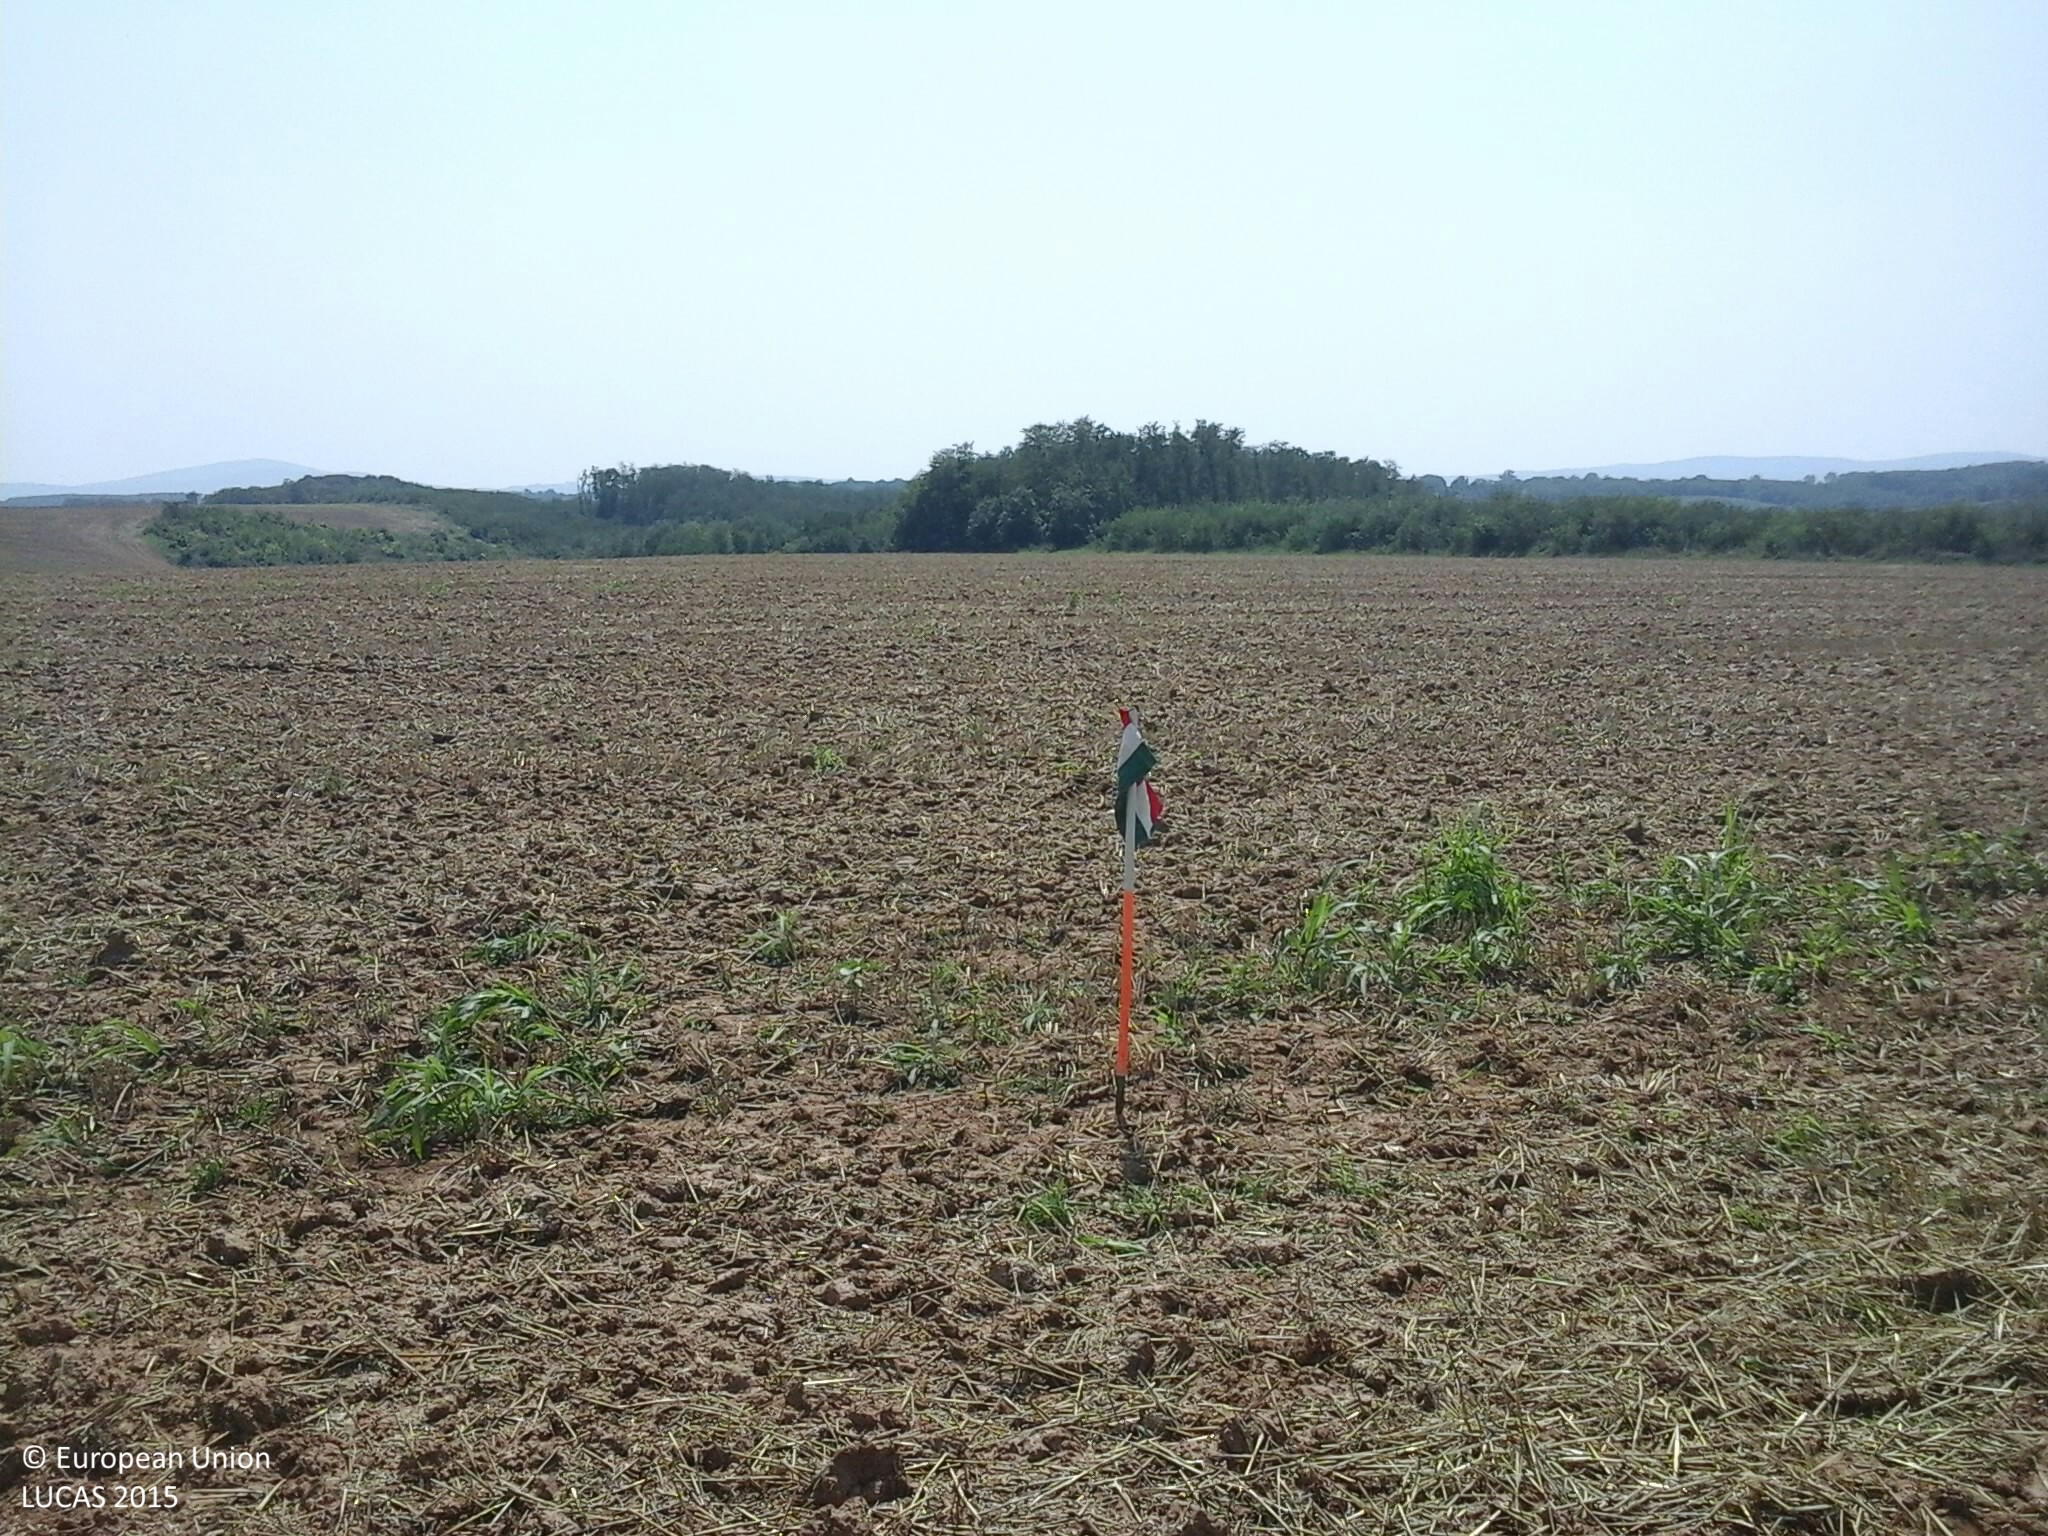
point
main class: Cropland
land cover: Common wheat
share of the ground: < 10 %
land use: Agriculture (excluding fallow land and kitchen gardens)
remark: Harvested field
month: August
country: HU
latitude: 45.9873
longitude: 18.3600
